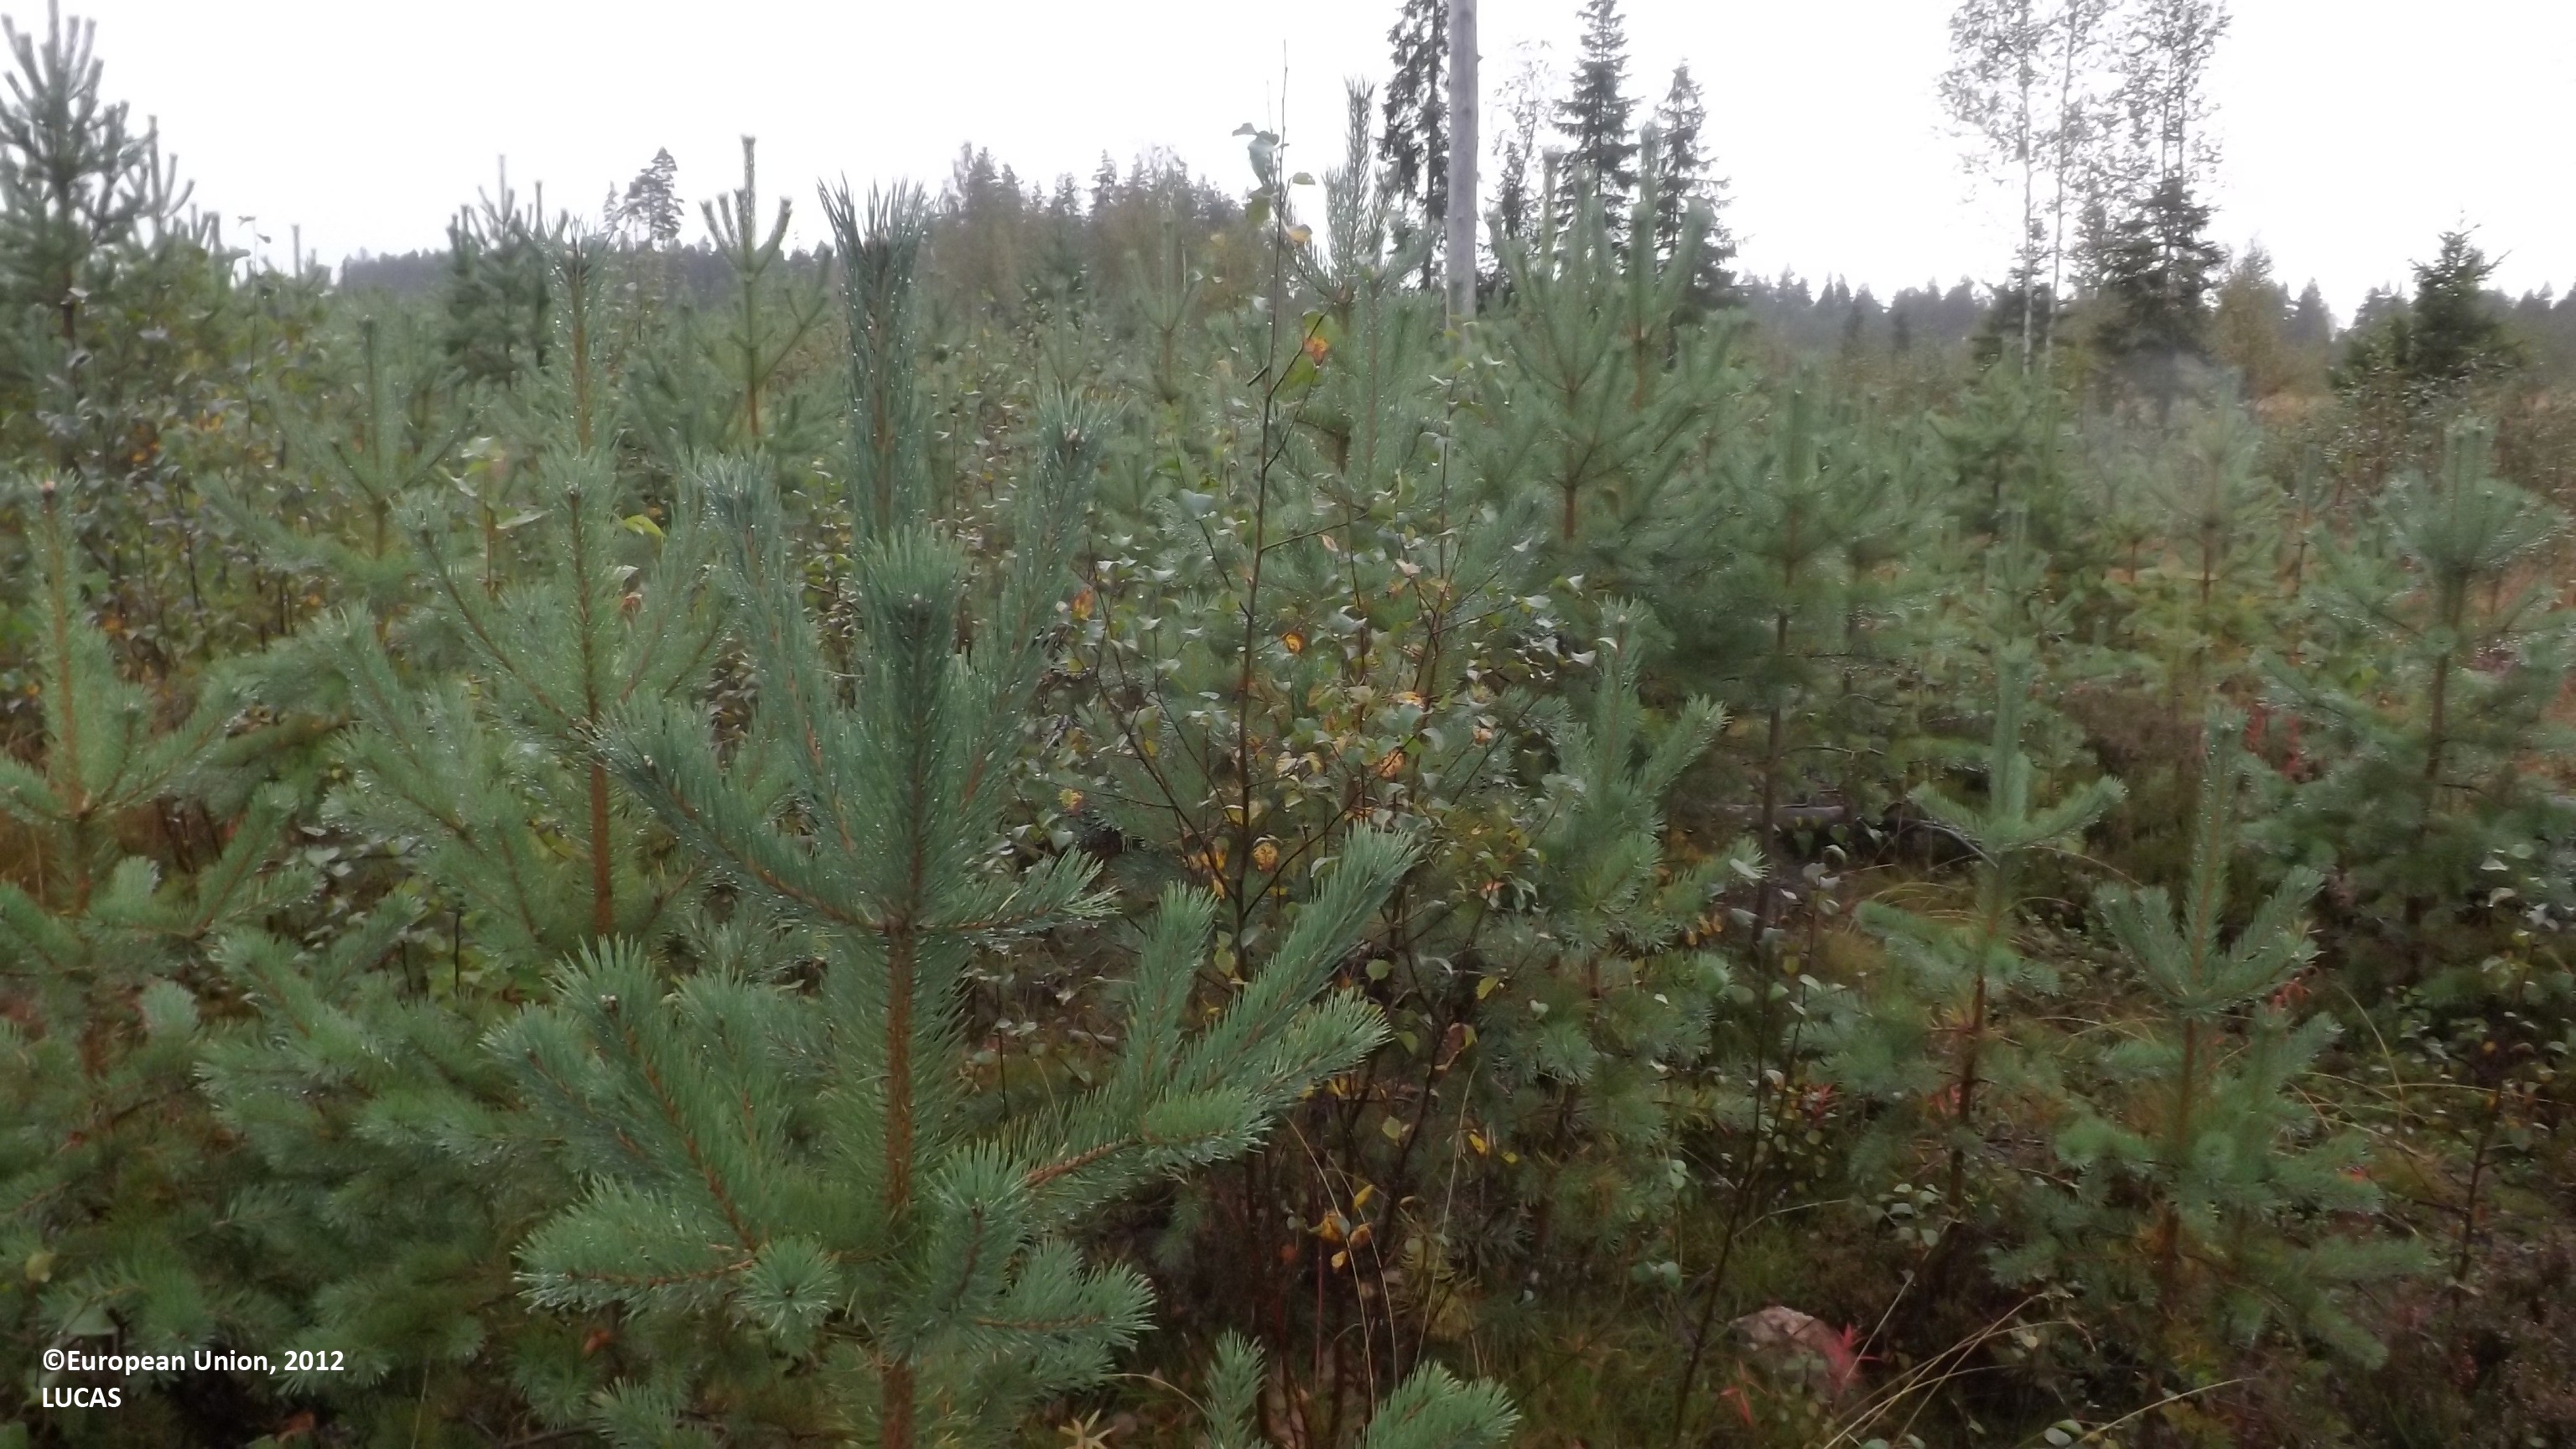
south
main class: Woodland
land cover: Pine dominated mixed woodland
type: boreal forest
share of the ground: 25 - 50 %
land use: Forestry
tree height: < 5 m
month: August
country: FI
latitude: 63.7700
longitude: 23.6283
